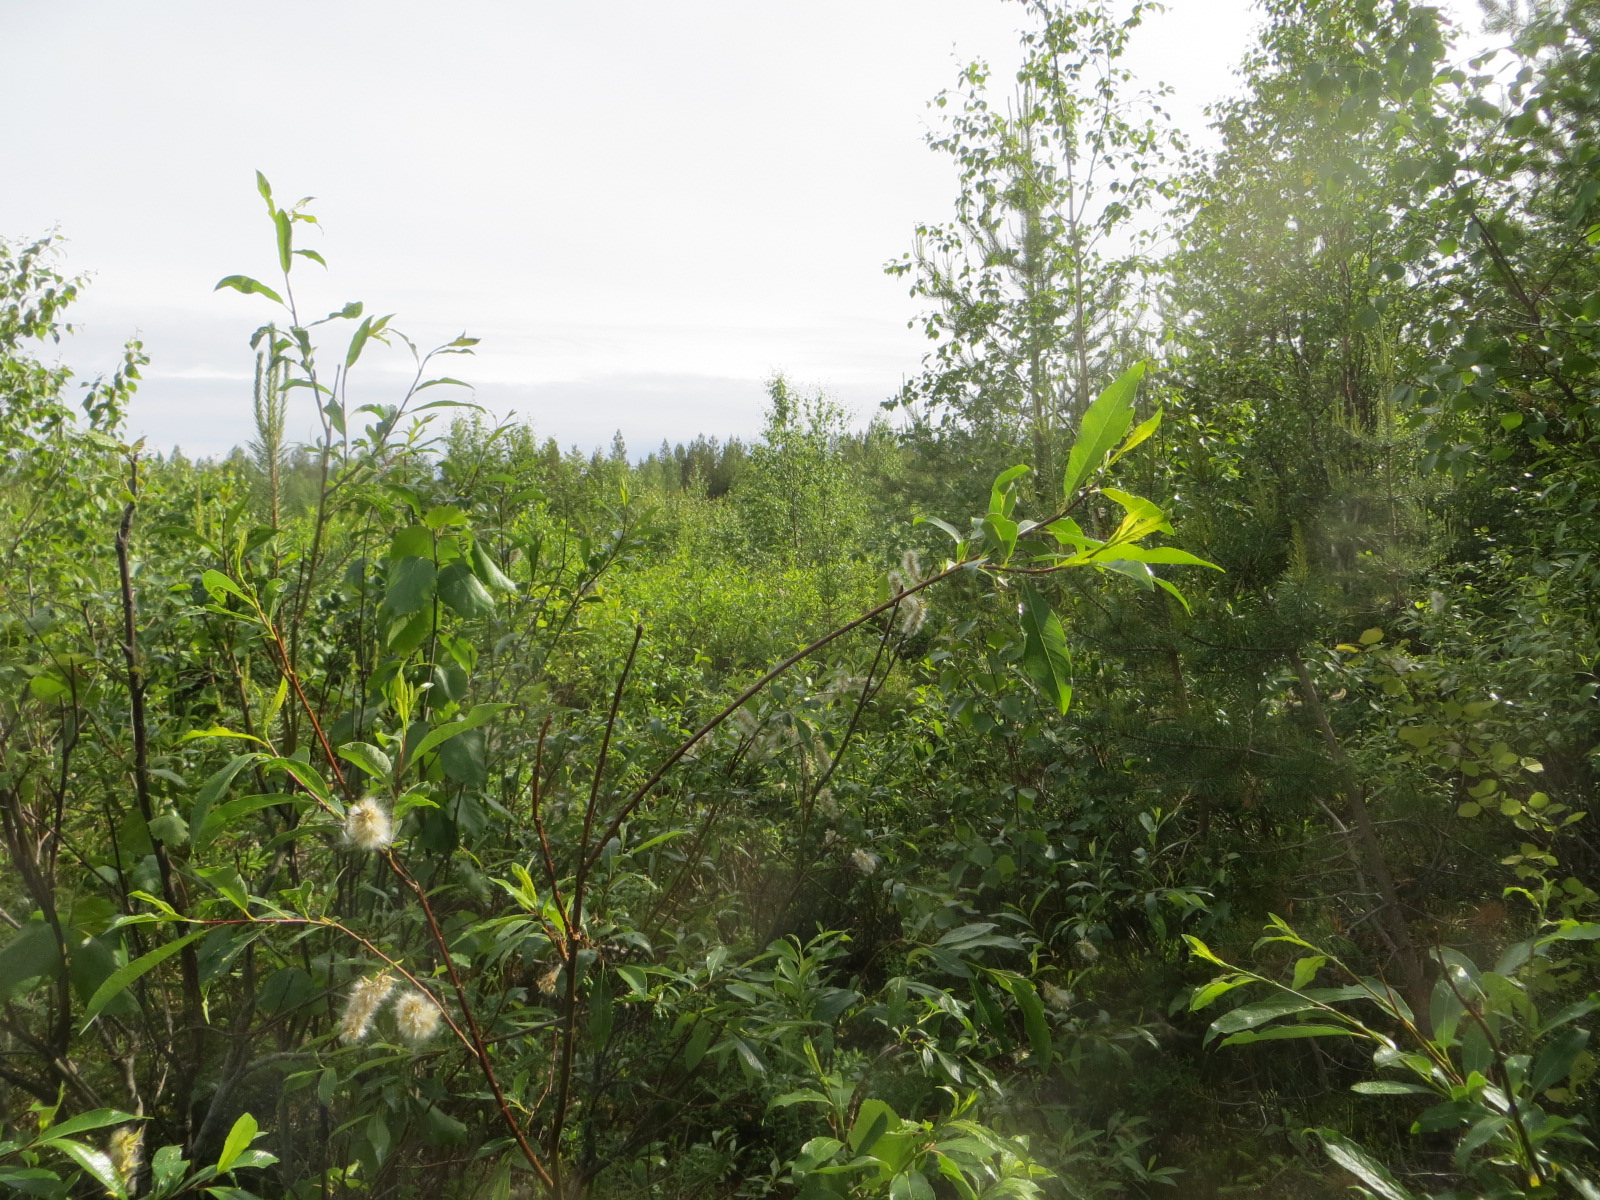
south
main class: Woodland
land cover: Broadleaved woodland
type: hemiboreal forest and nemoral coniferous forest and mixed broadleaved-coniferous forest
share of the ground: > 75 %
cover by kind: broadleaved forest trees 85 %, coniferous forest trees 10 %, shrubs 5 %
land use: Forestry
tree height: < 5 m
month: June
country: FI
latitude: 65.5086
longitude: 26.1549
